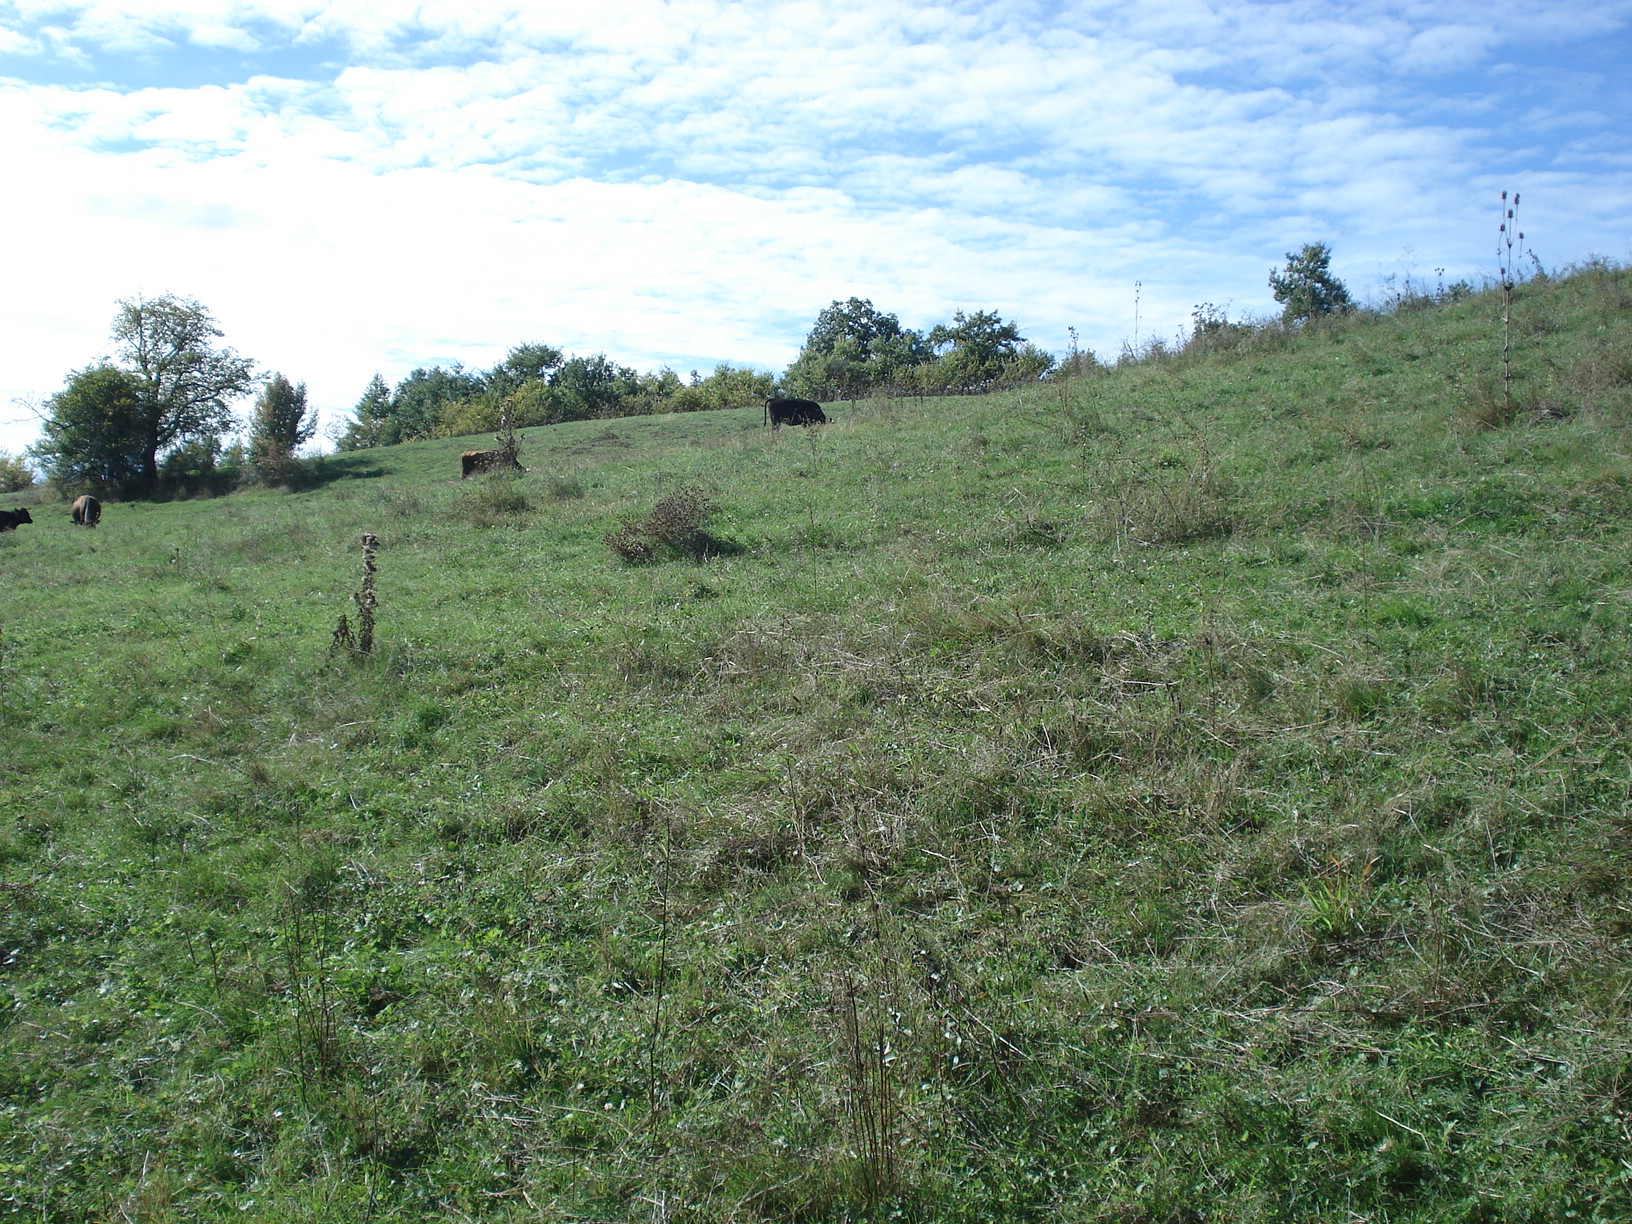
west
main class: Grassland
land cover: Grassland without tree/shrub cover
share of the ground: > 75 %
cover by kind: herbaceous plants 100 %
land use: Agriculture (excluding fallow land and kitchen gardens)
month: October
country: BG
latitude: 42.9572
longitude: 26.0853
